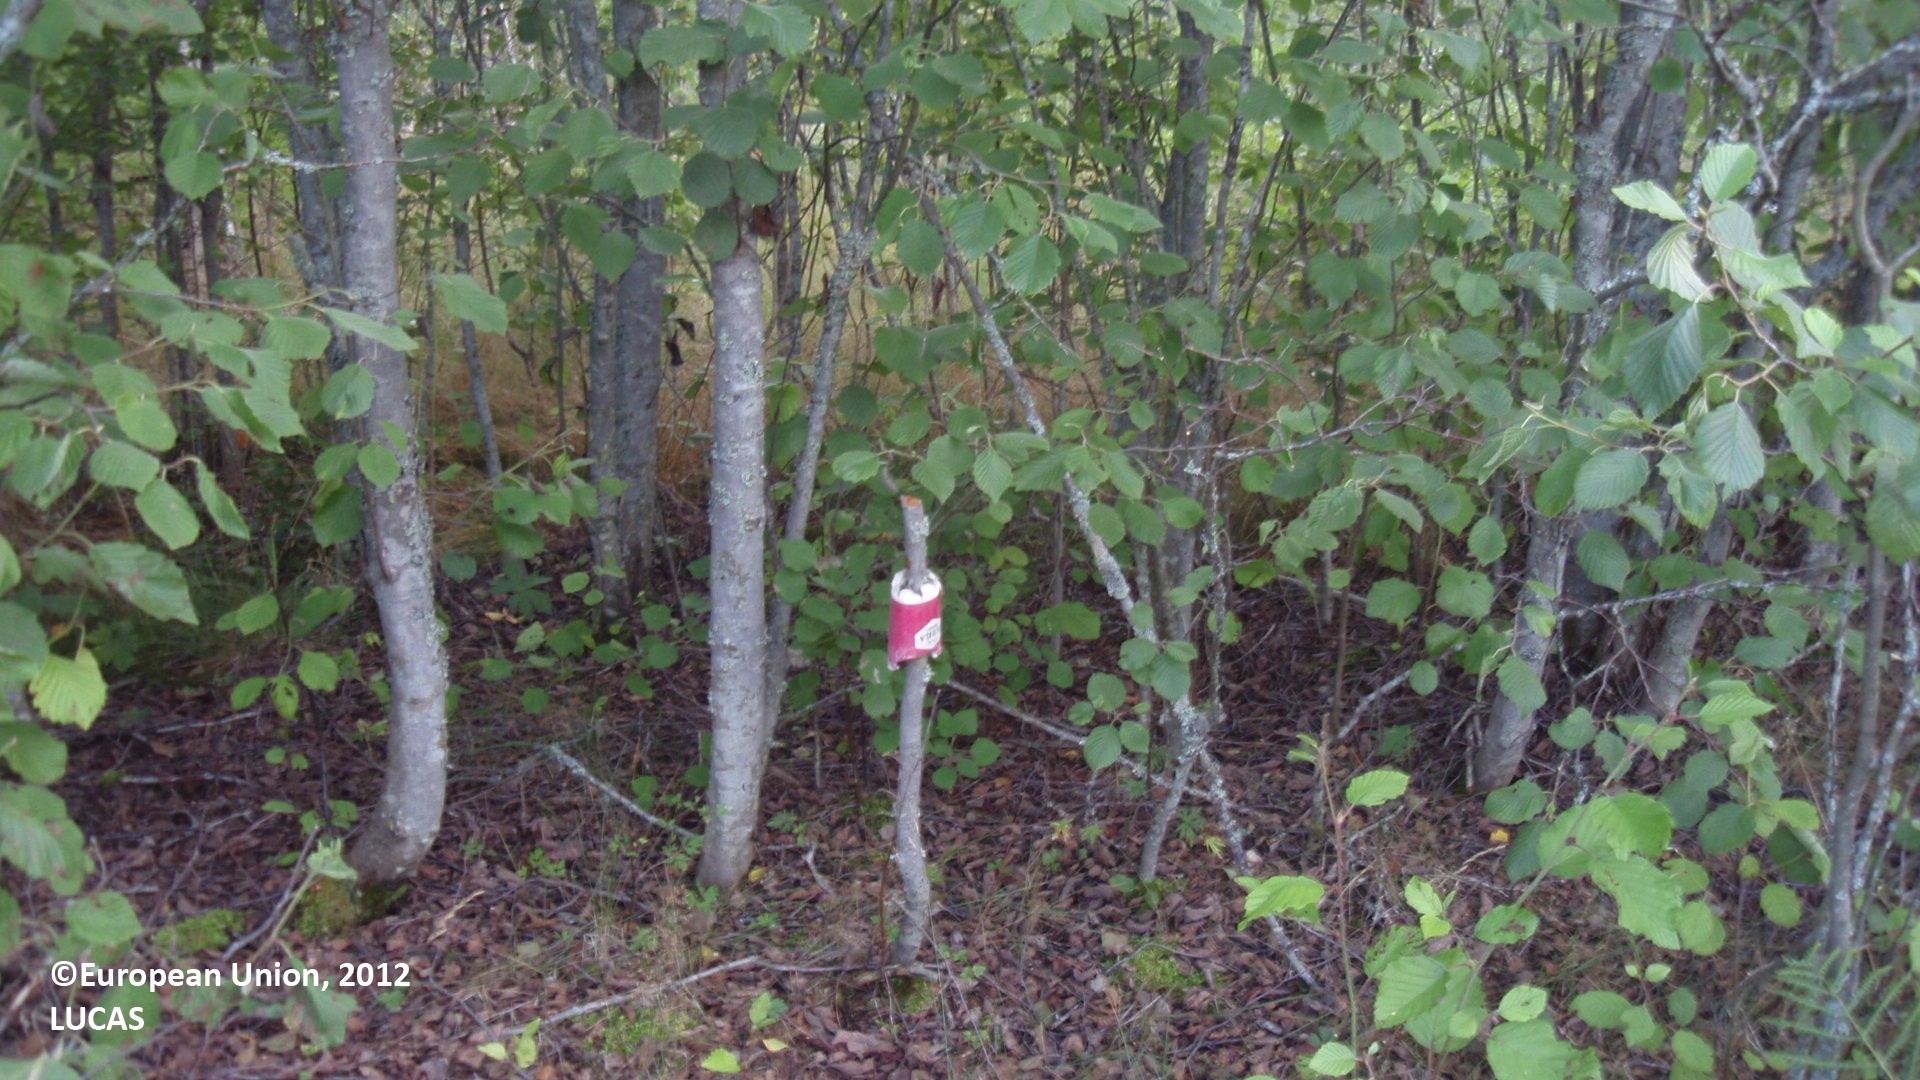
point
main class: Woodland
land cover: Broadleaved woodland
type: non-riverine alder, birch or aspen forest
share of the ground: > 75 %
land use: Forestry
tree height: > 5 m
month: August
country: FI
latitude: 60.6716
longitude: 26.6870
